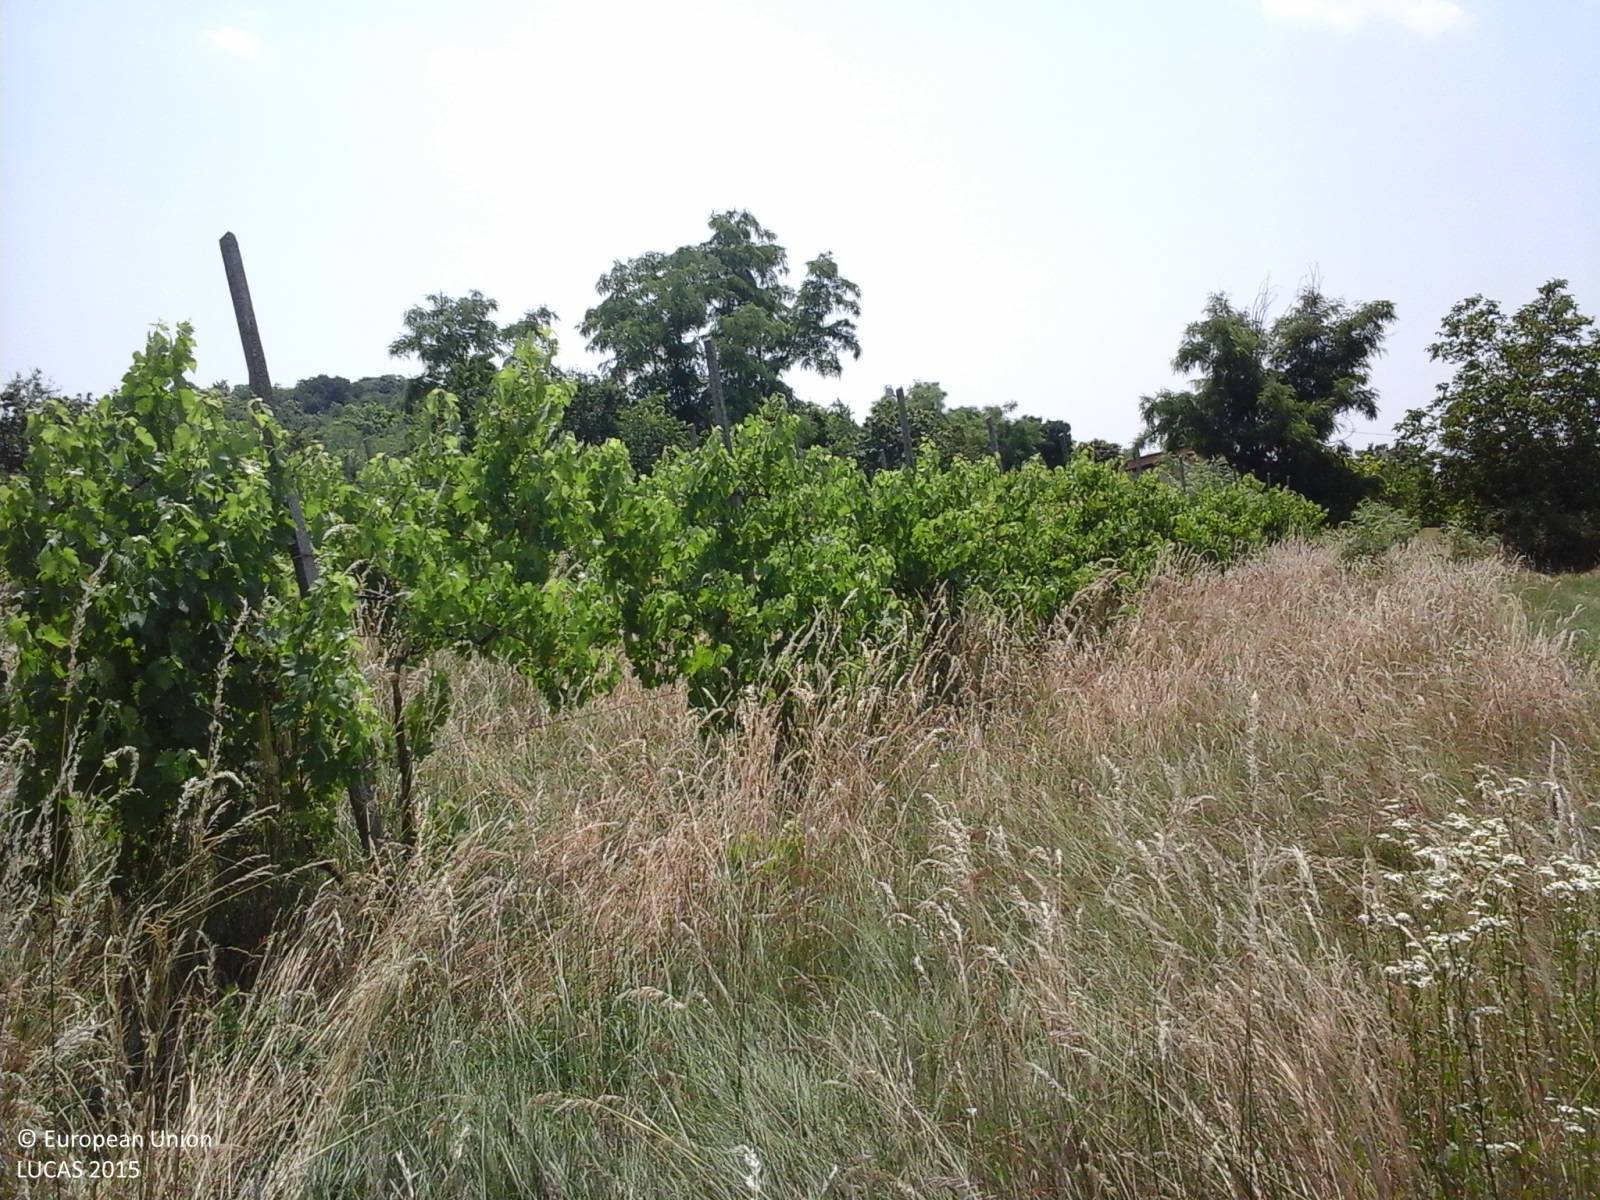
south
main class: Cropland
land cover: Vineyards
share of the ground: > 75 %
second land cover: Grassland without tree/shrub cover
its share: > 75 %
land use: Agriculture (excluding fallow land and kitchen gardens)
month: June
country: IT
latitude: 46.0507
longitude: 12.5429
